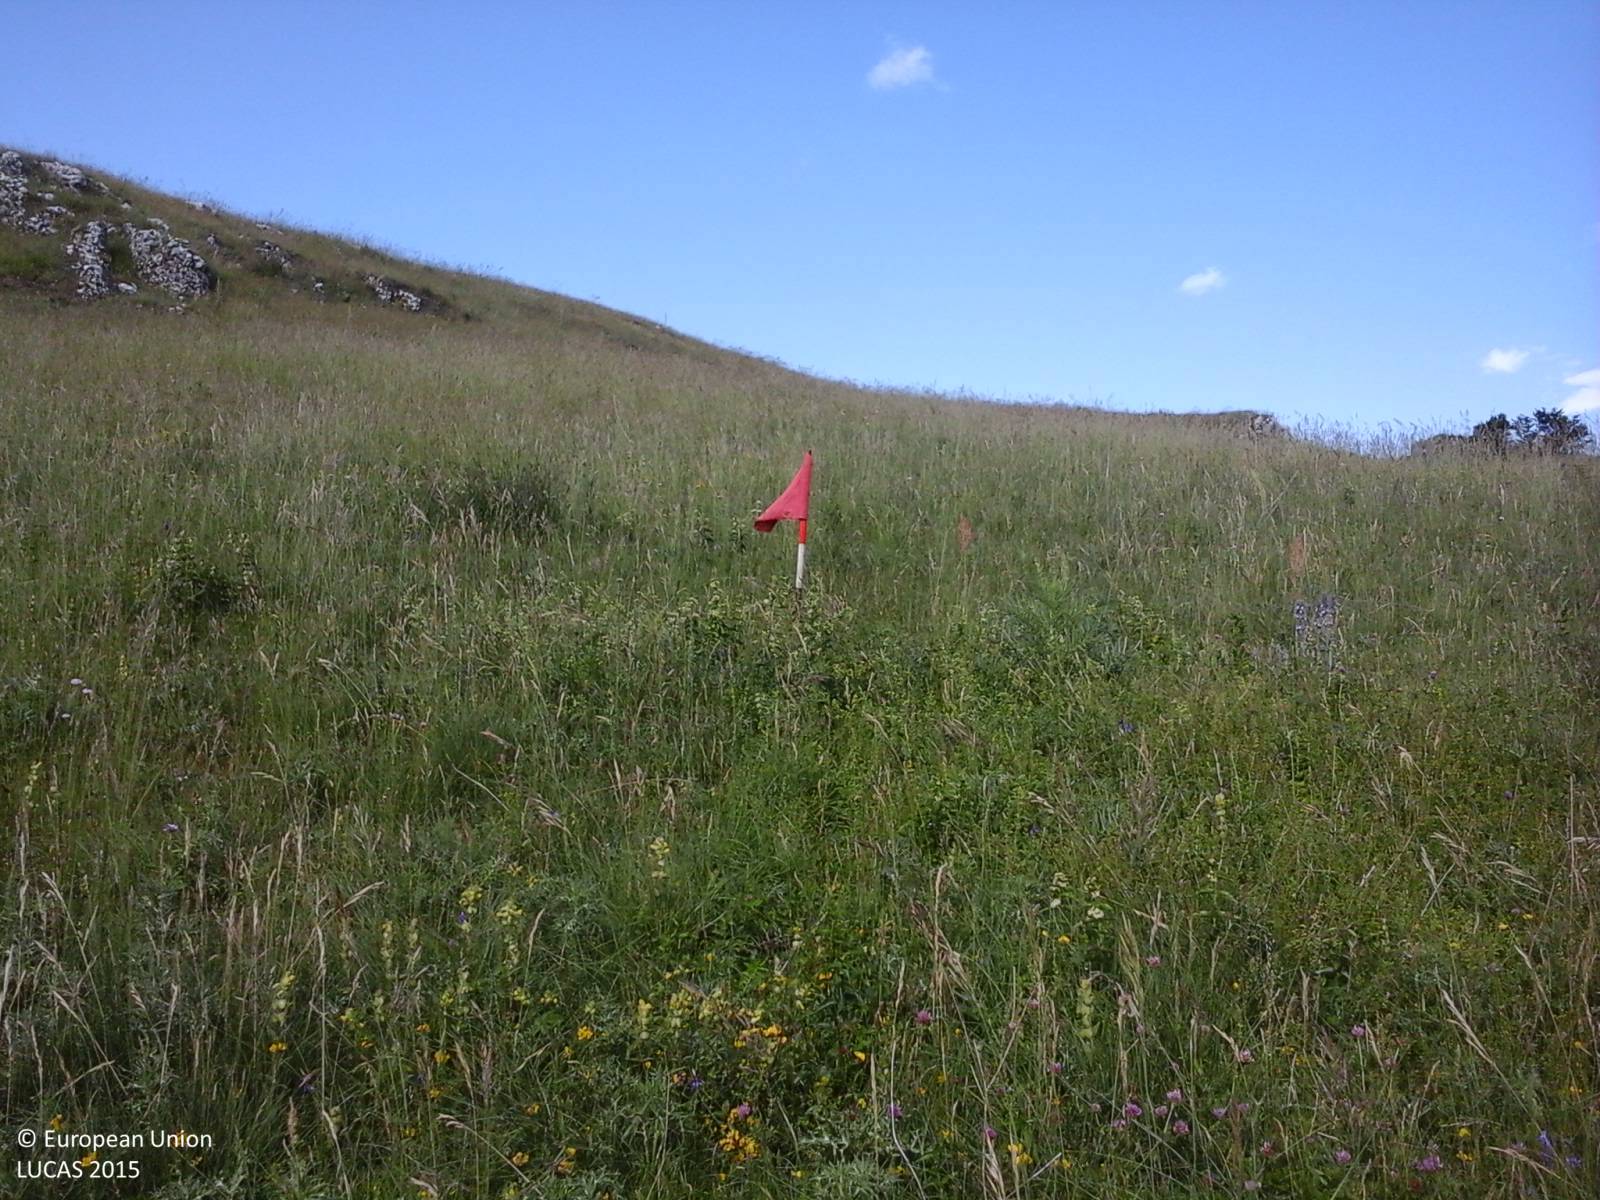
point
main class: Grassland
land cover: Grassland without tree/shrub cover
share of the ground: > 75 %
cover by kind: herbaceous plants 100 %
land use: Agriculture (excluding fallow land and kitchen gardens)
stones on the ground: 25 - 50 %
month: June
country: IT
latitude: 41.4016
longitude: 14.3737
